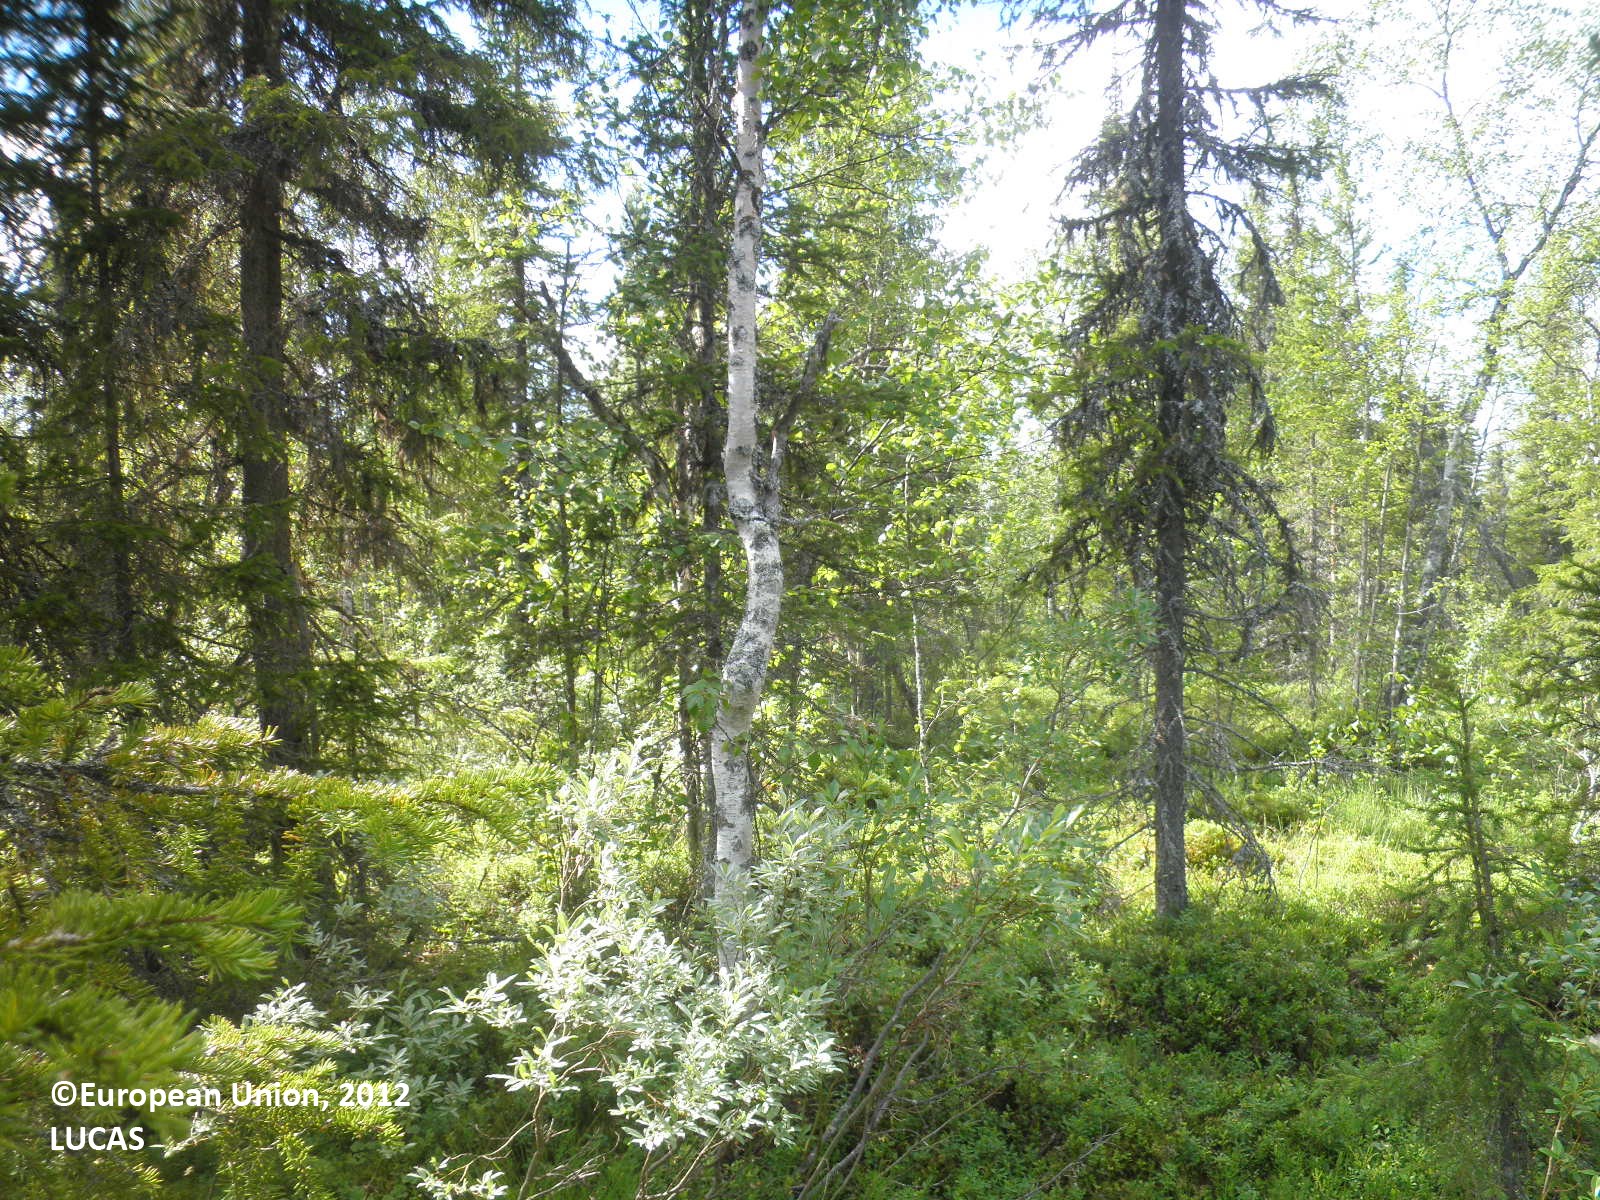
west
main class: Woodland
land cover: Spruce dominated mixed woodland
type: boreal forest
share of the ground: 50 - 75 %
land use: Forestry
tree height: > 5 m
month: July
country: FI
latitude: 67.6191
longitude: 25.8460
